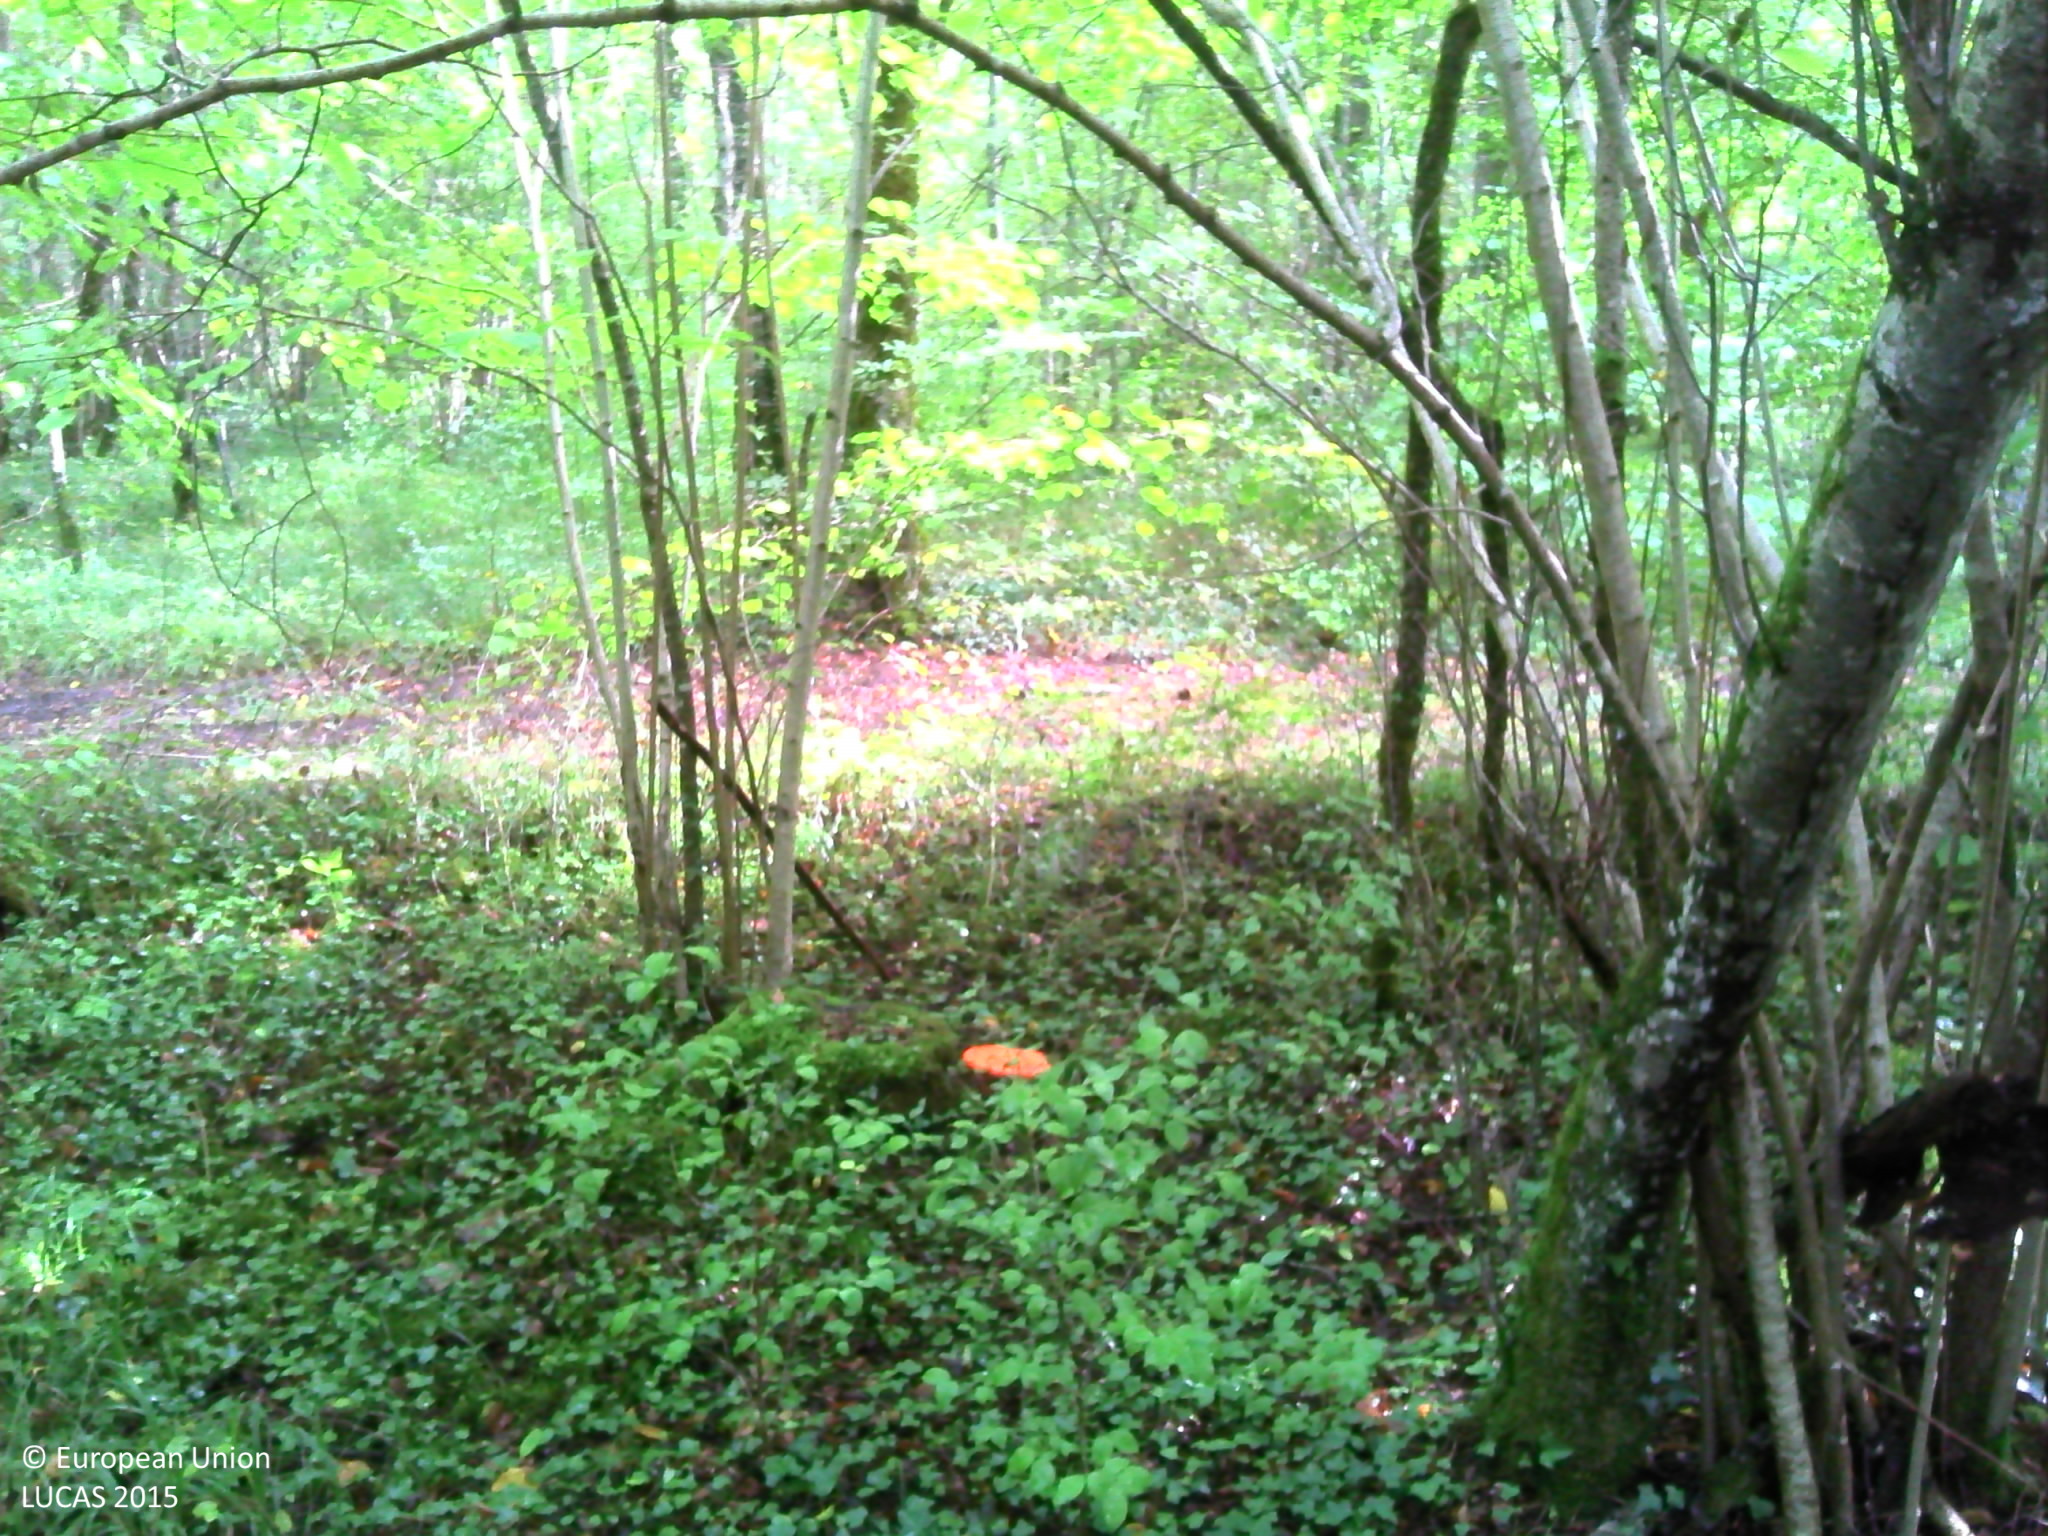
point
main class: Woodland
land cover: Broadleaved woodland
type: mesophytic deciduous forest
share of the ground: > 75 %
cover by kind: broadleaved forest trees 90 %, herbaceous plants 5 %, lichens and mosses 5 %
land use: Forestry
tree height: > 5 m
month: September
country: FR
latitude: 47.6784
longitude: 4.2838
